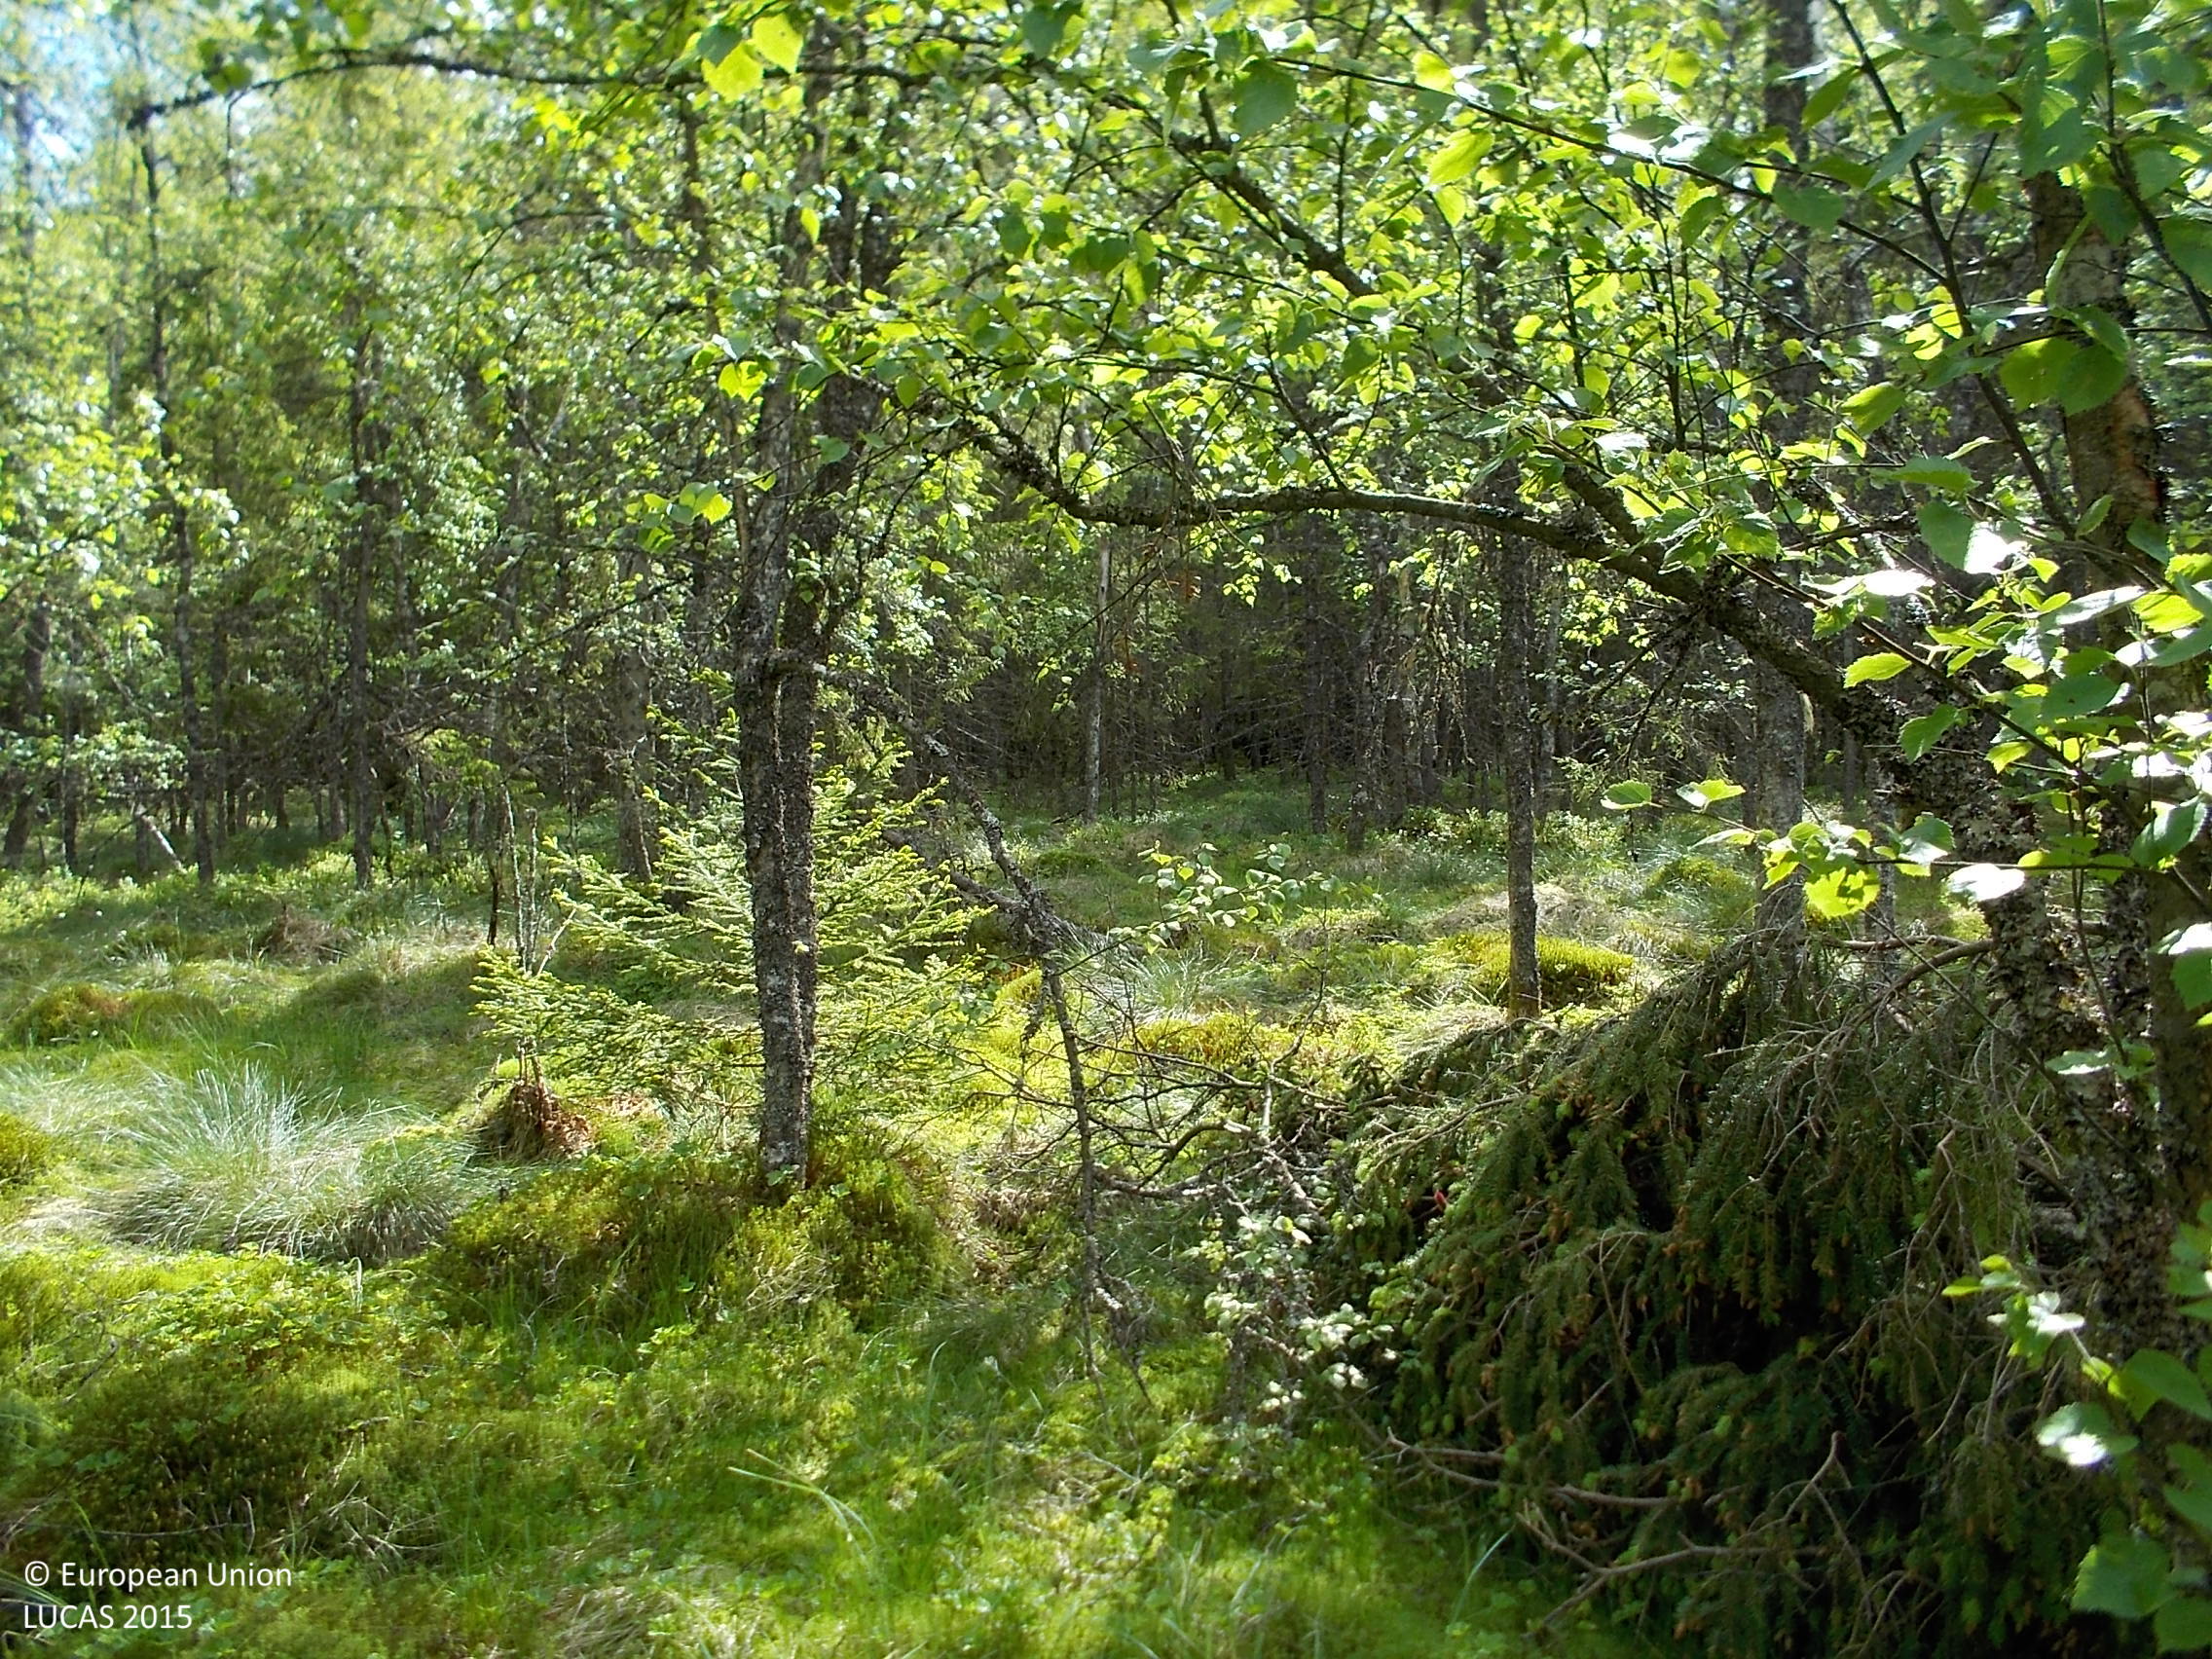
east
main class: Woodland
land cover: Spruce dominated mixed woodland
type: mire and swamp forests
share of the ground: 50 - 75 %
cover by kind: coniferous forest trees 40 %, broadleaved forest trees 20 %, herbaceous plants 20 %, lichens and mosses 20 %
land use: Semi-natural and natural areas not in use
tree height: > 5 m
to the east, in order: Spruce dominated mixed woodland; Spruce dominated coniferous woodland; Spruce dominated mixed woodland; Spruce dominated coniferous woodland; Dry stone walls; Spruce dominated coniferous woodland
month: June
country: SE
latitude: 57.6799
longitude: 13.0979
